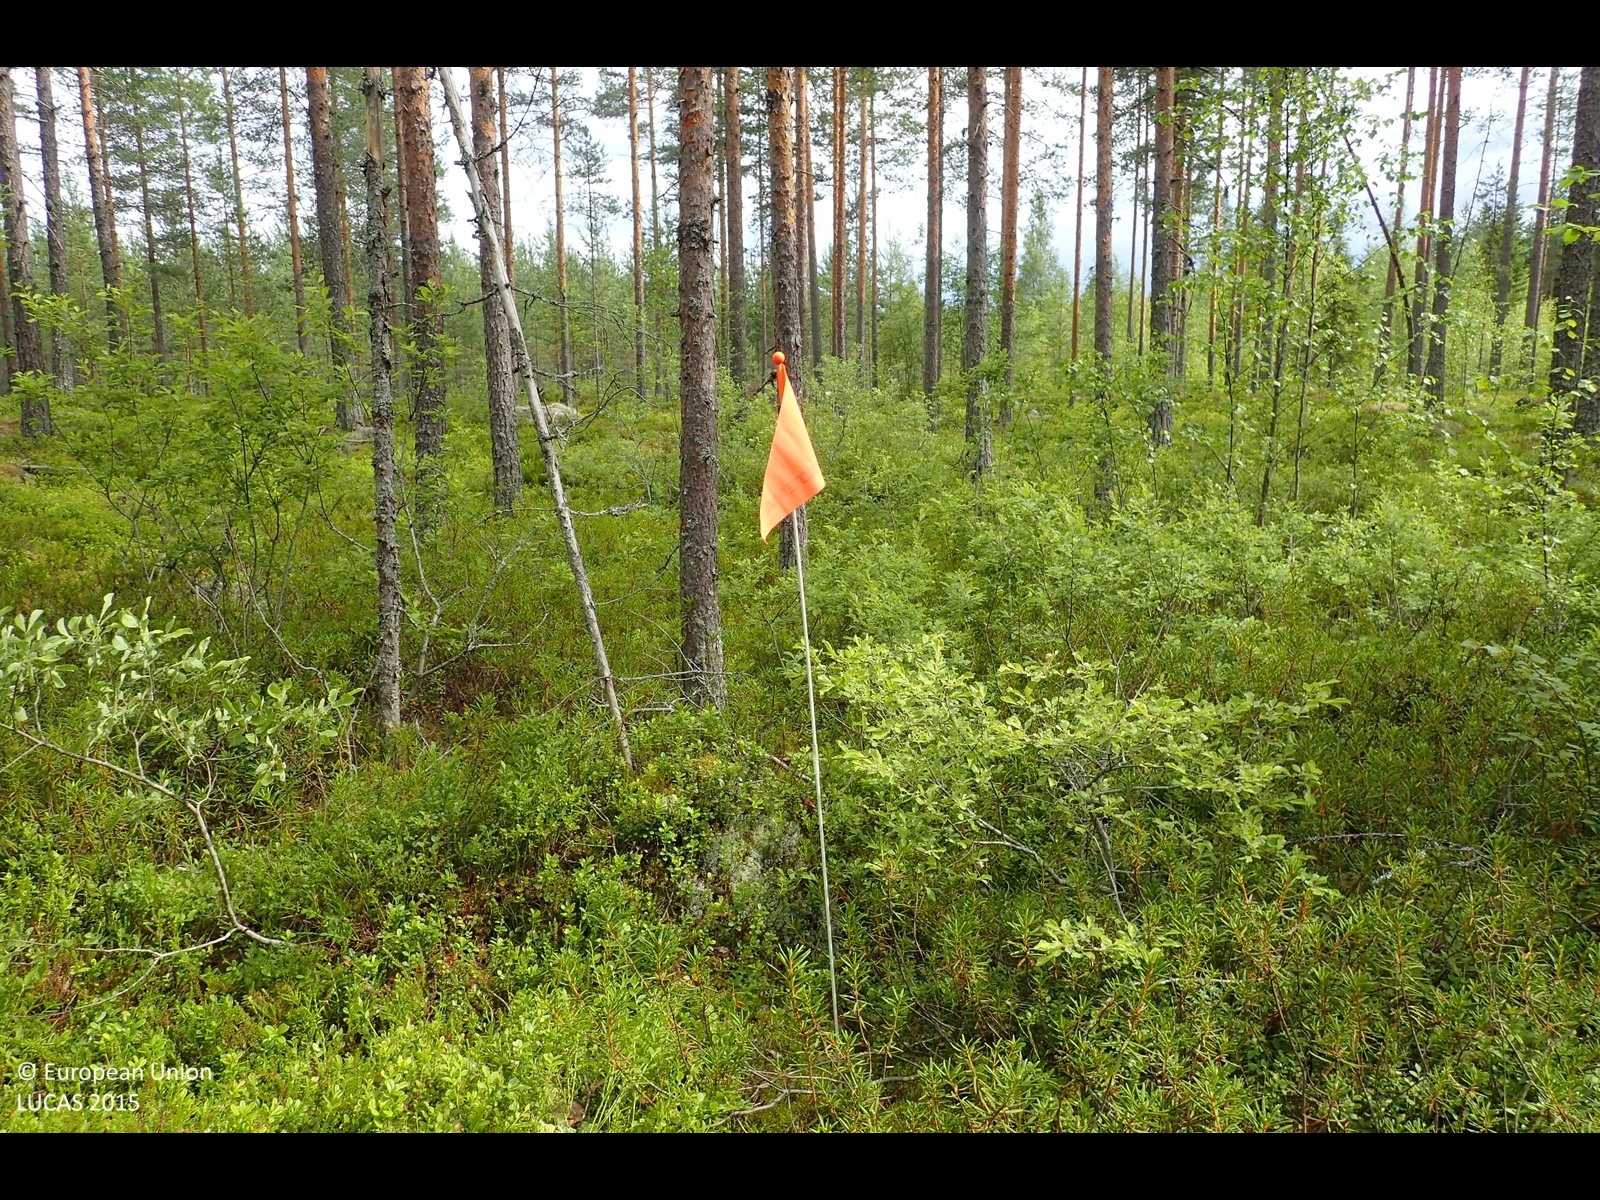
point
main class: Woodland
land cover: Pine dominated coniferous woodland
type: boreal forest
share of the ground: 50 - 75 %
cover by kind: coniferous forest trees 45 %, shrubs 45 %, broadleaved forest trees 5 %, lichens and mosses 5 %
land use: Forestry
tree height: > 5 m
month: July
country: FI
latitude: 62.6067
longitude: 23.4933
